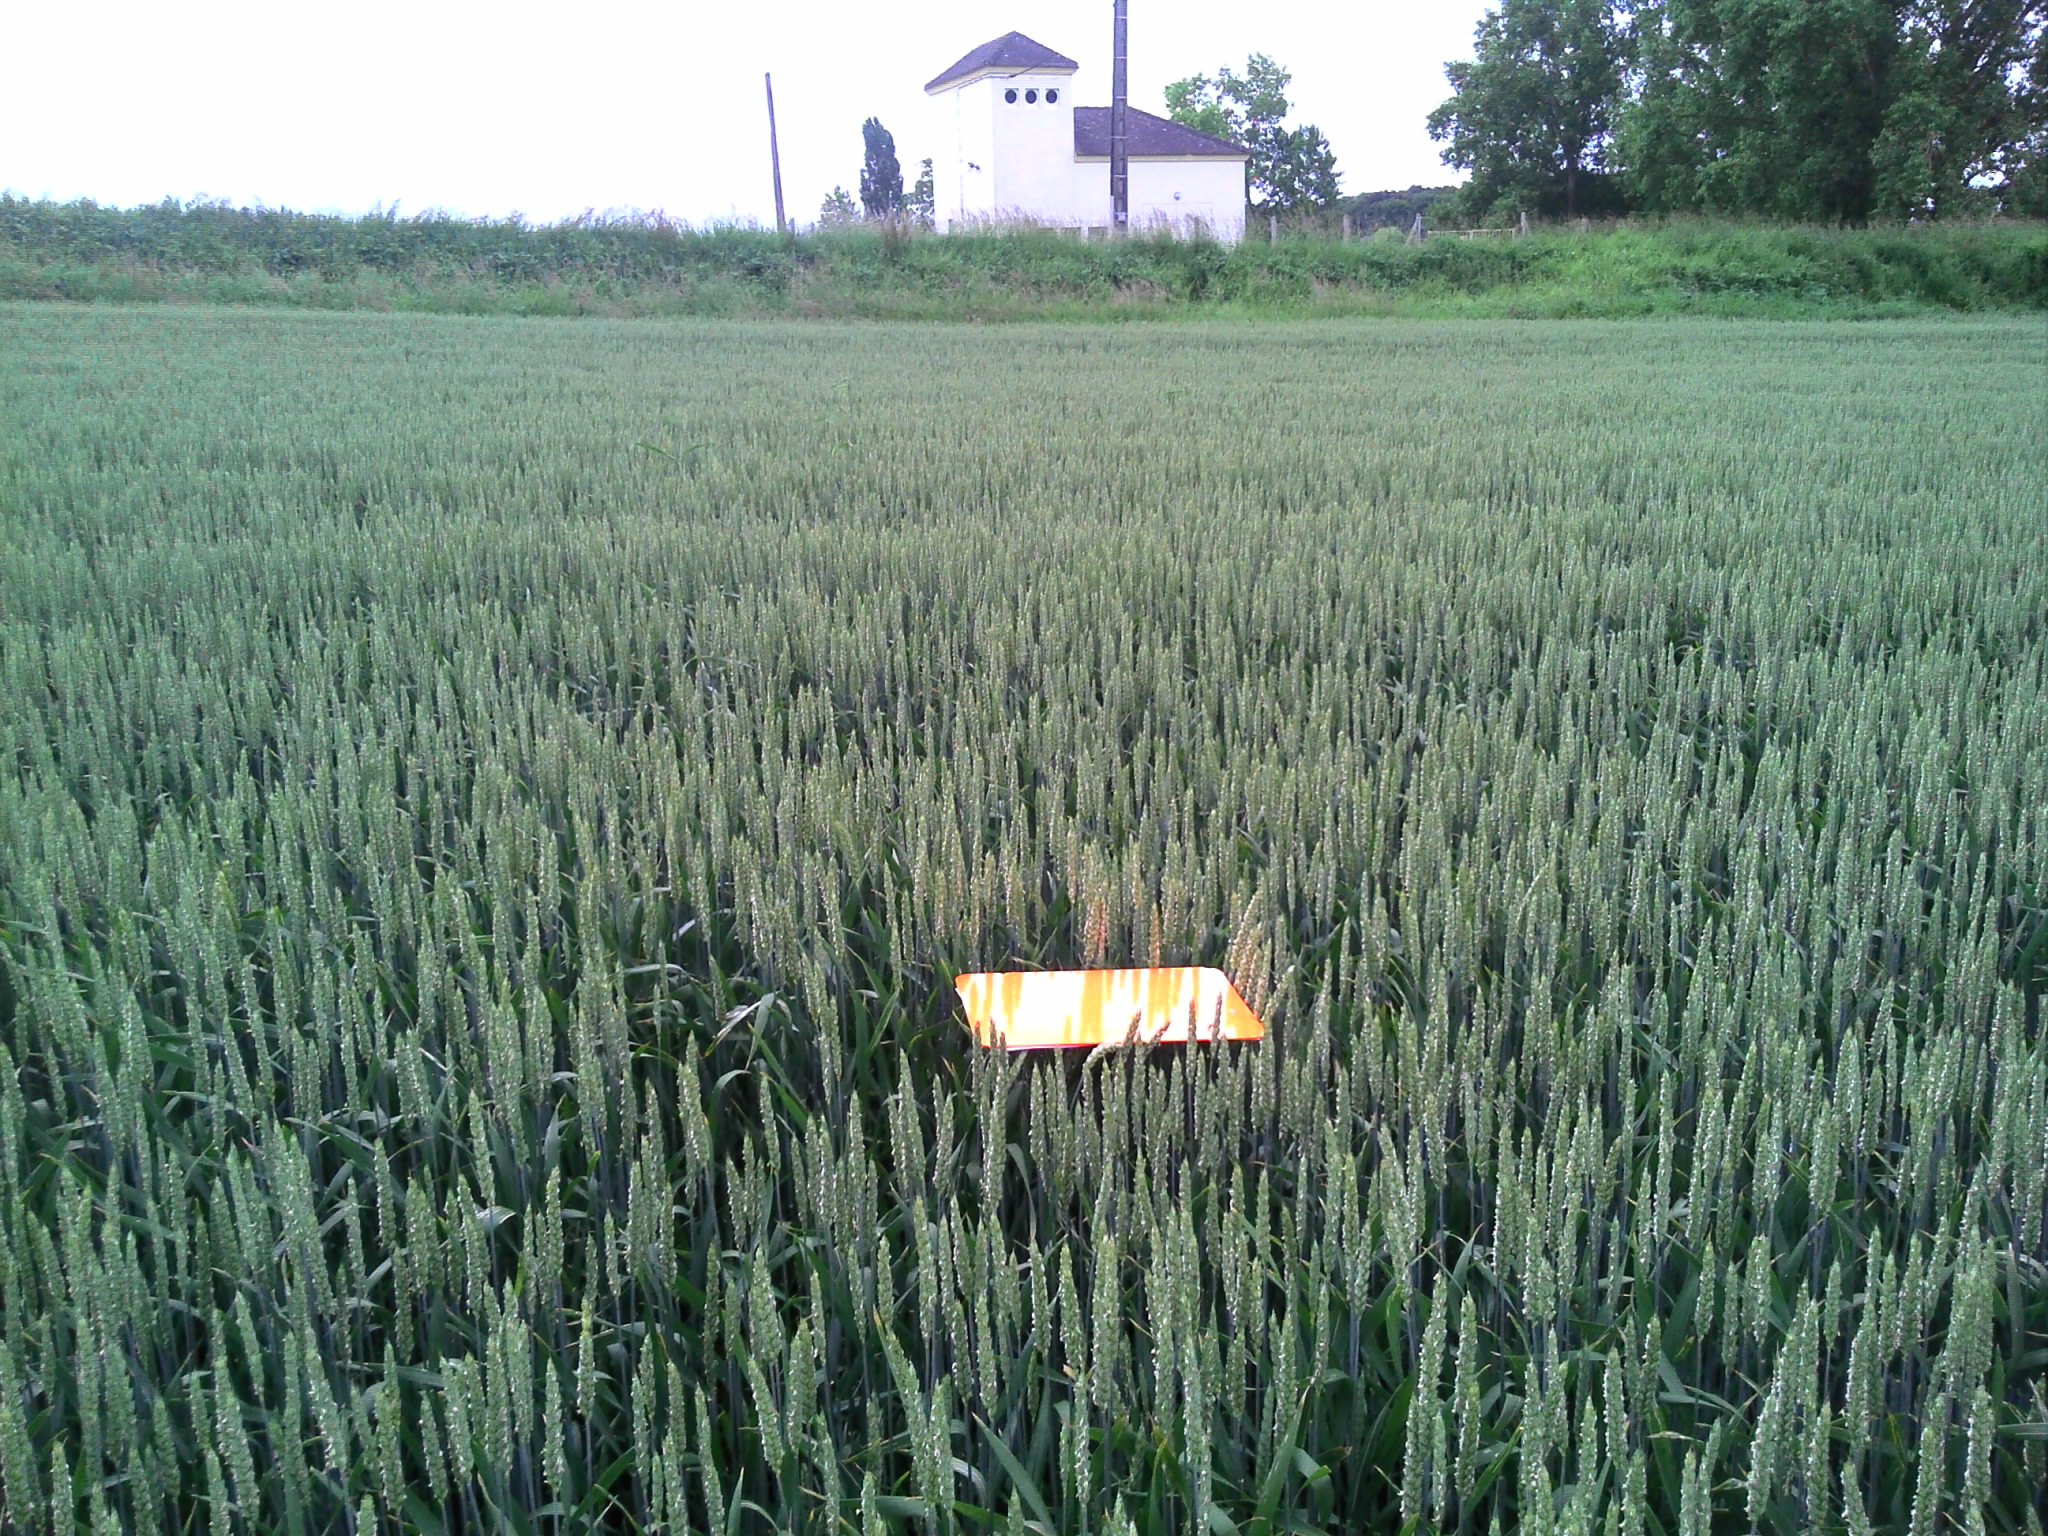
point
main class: Cropland
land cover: Common wheat
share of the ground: > 75 %
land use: Agriculture (excluding fallow land and kitchen gardens)
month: June
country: FR
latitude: 46.9347
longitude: 0.6163
